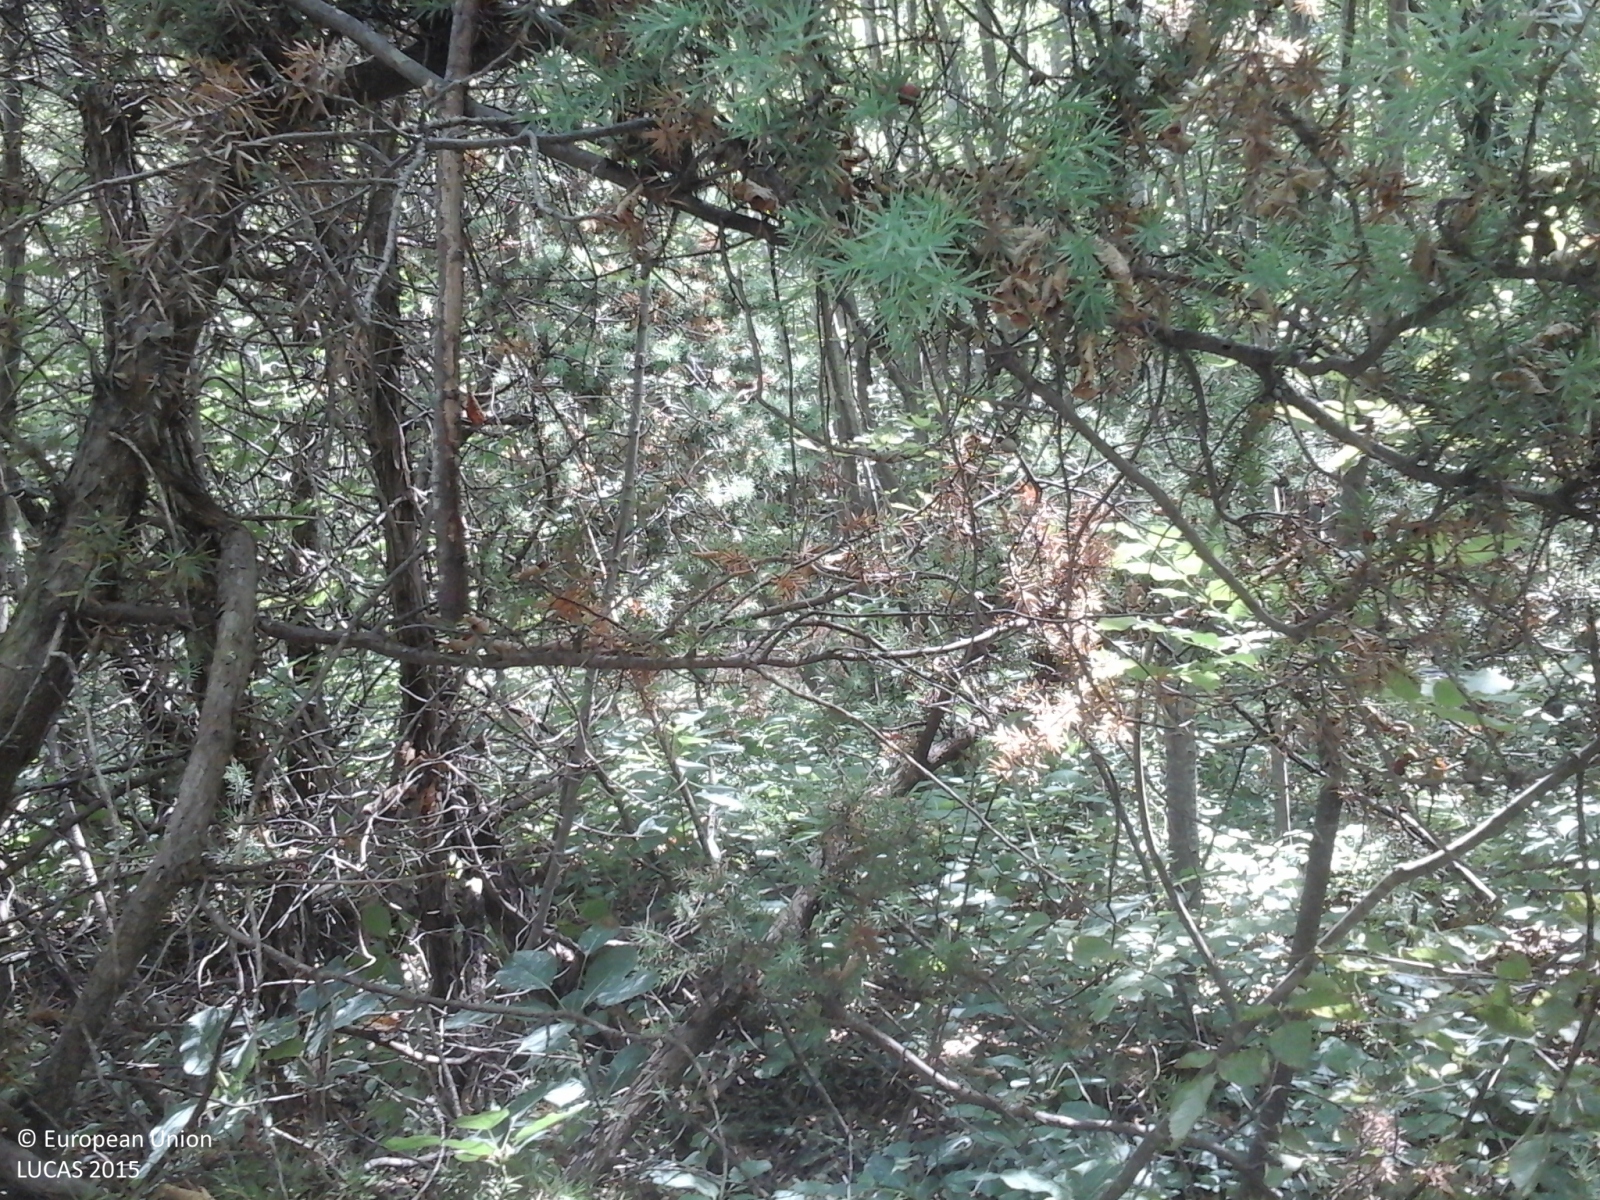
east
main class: Woodland
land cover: Broadleaved woodland
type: mountainous beech forest
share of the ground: > 75 %
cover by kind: broadleaved forest trees 95 %, coniferous forest trees 5 %
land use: Forestry
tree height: > 5 m
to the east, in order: Broadleaved woodland; Pine dominated coniferous woodland
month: August
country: IT
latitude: 43.3071
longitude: 13.2339
